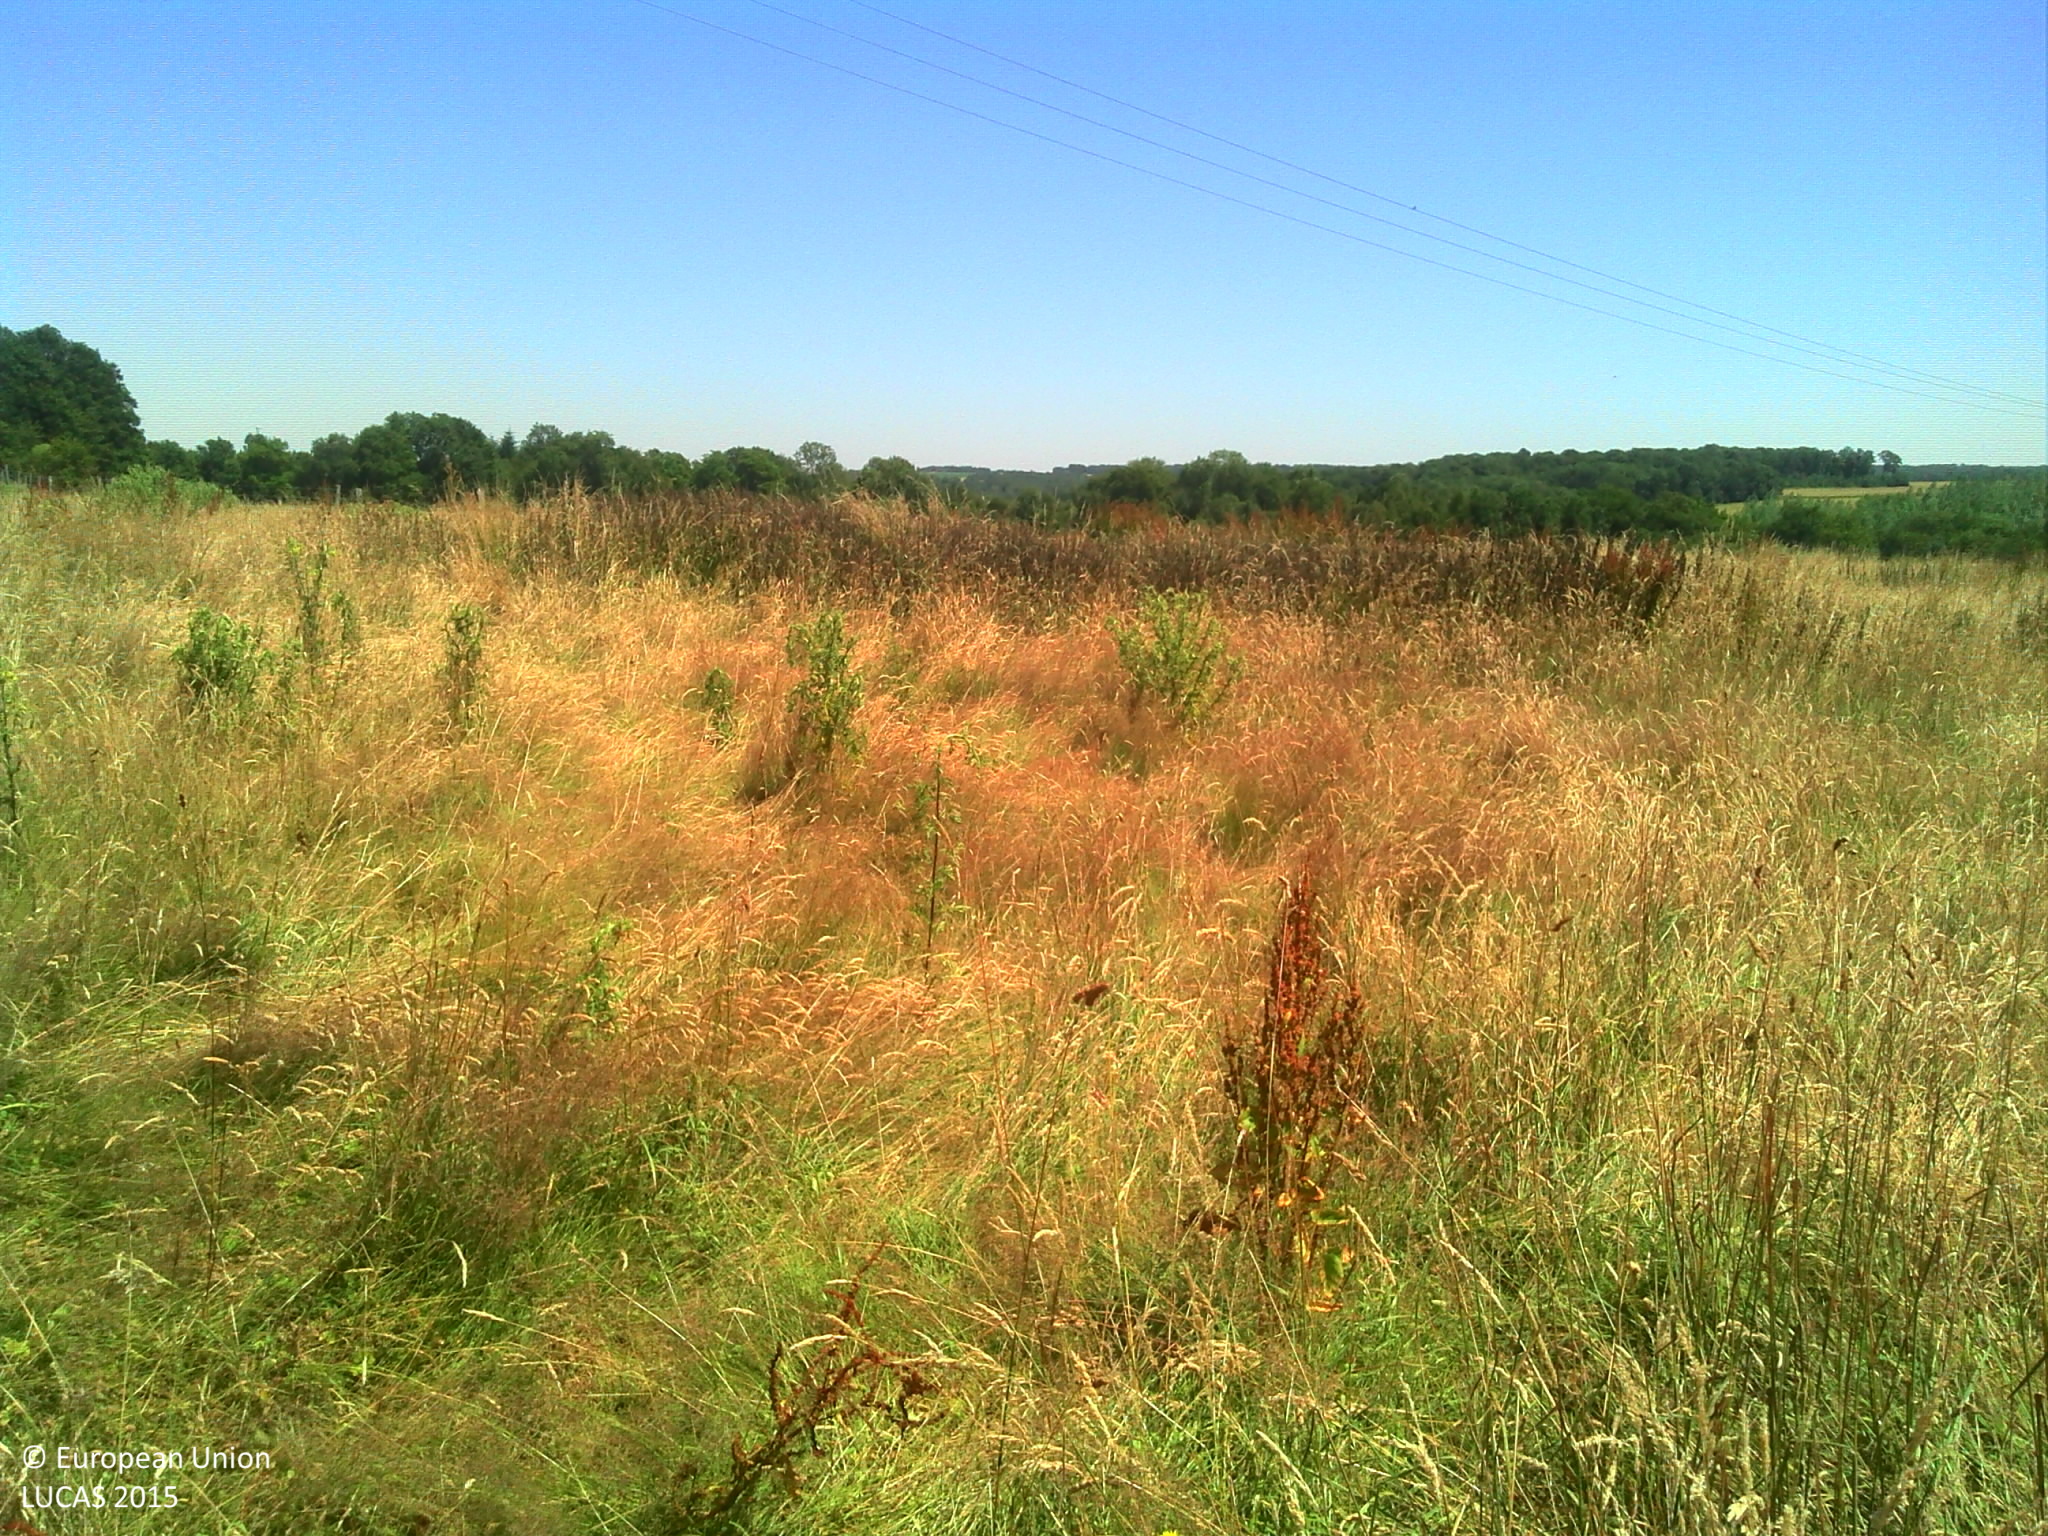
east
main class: Grassland
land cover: Grassland without tree/shrub cover
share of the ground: > 75 %
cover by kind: herbaceous plants 100 %
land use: Agriculture (excluding fallow land and kitchen gardens)
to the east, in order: Grassland without tree/shrub cover; Electric lines; Grassland without tree/shrub cover; Fences; Grassland without tree/shrub cover; Fences; Grassland without tree/shrub cover; Fences; Grassland without tree/shrub cover
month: June
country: FR
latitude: 48.9413
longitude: 3.3164
